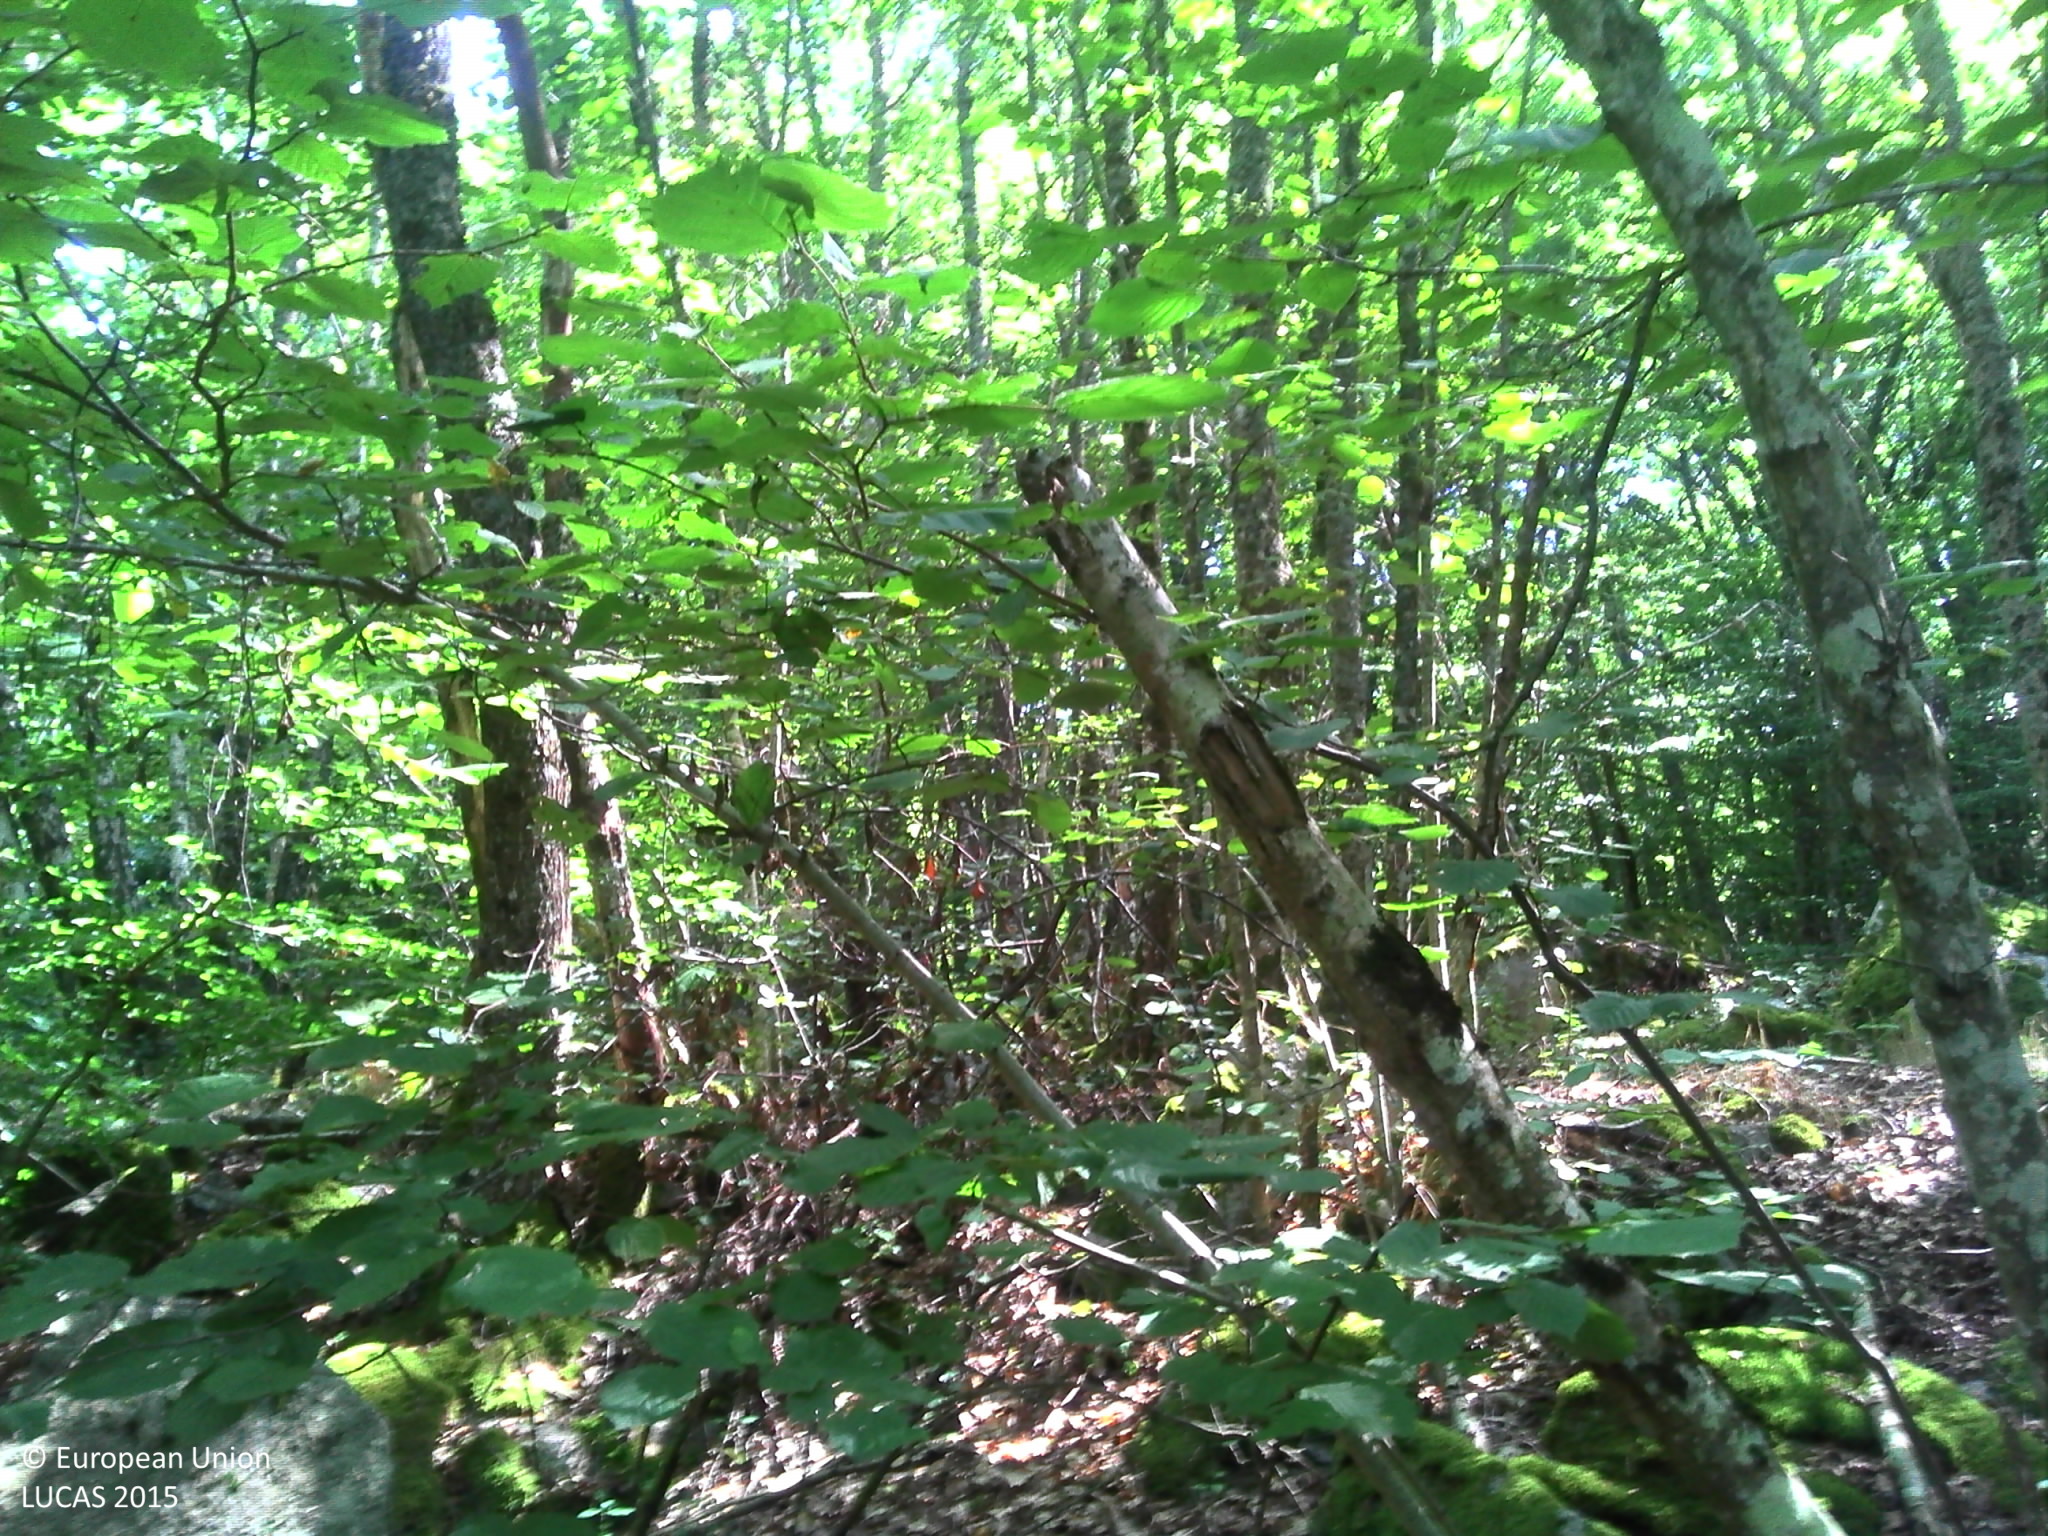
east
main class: Woodland
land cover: Broadleaved woodland
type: acidophilous oak and oak-birch forest
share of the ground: > 75 %
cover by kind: broadleaved forest trees 65 %, shrubs 10 %, herbaceous plants 10 %, consolidated bare surface 10 %, lichens and mosses 5 %
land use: Forestry
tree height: > 5 m
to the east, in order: Broadleaved woodland; Rock outcrops; Broadleaved woodland; Spruce dominated coniferous woodland; Broadleaved woodland
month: August
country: FR
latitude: 45.9501
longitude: 2.3460
